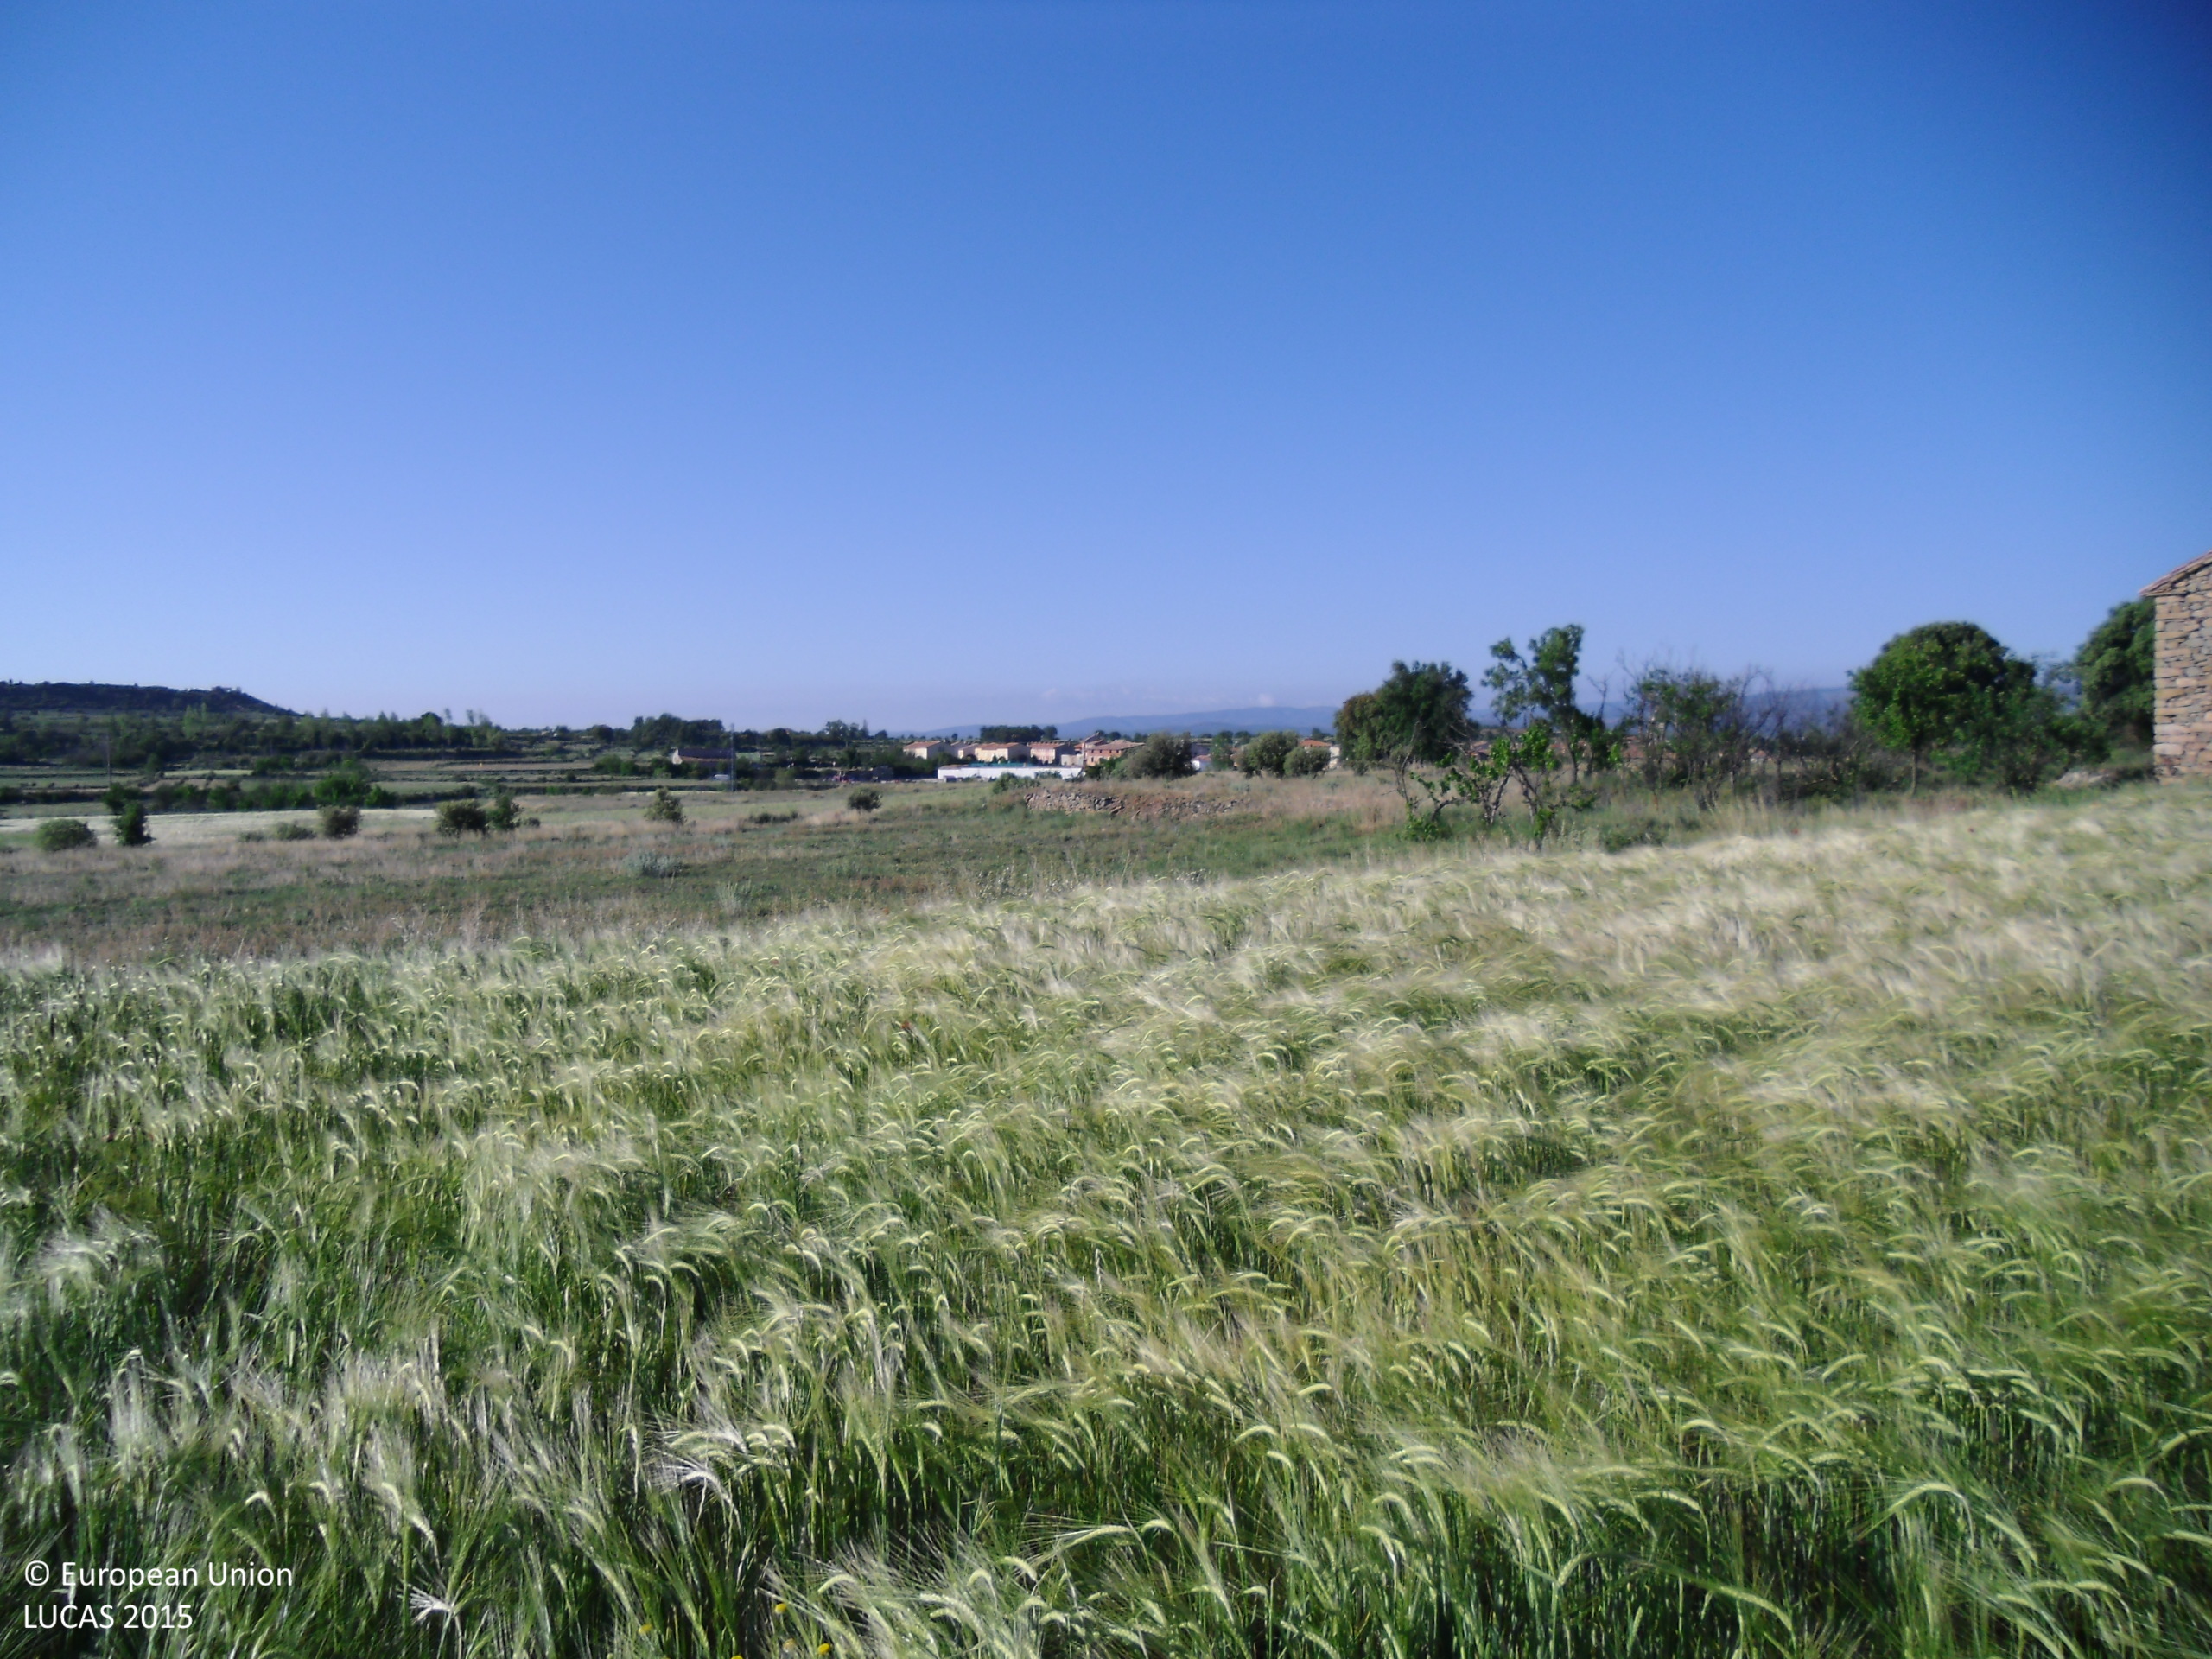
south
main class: Cropland
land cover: Barley
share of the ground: > 75 %
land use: Agriculture (excluding fallow land and kitchen gardens)
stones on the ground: < 10 %
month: May
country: ES
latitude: 40.2337
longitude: -0.8089
